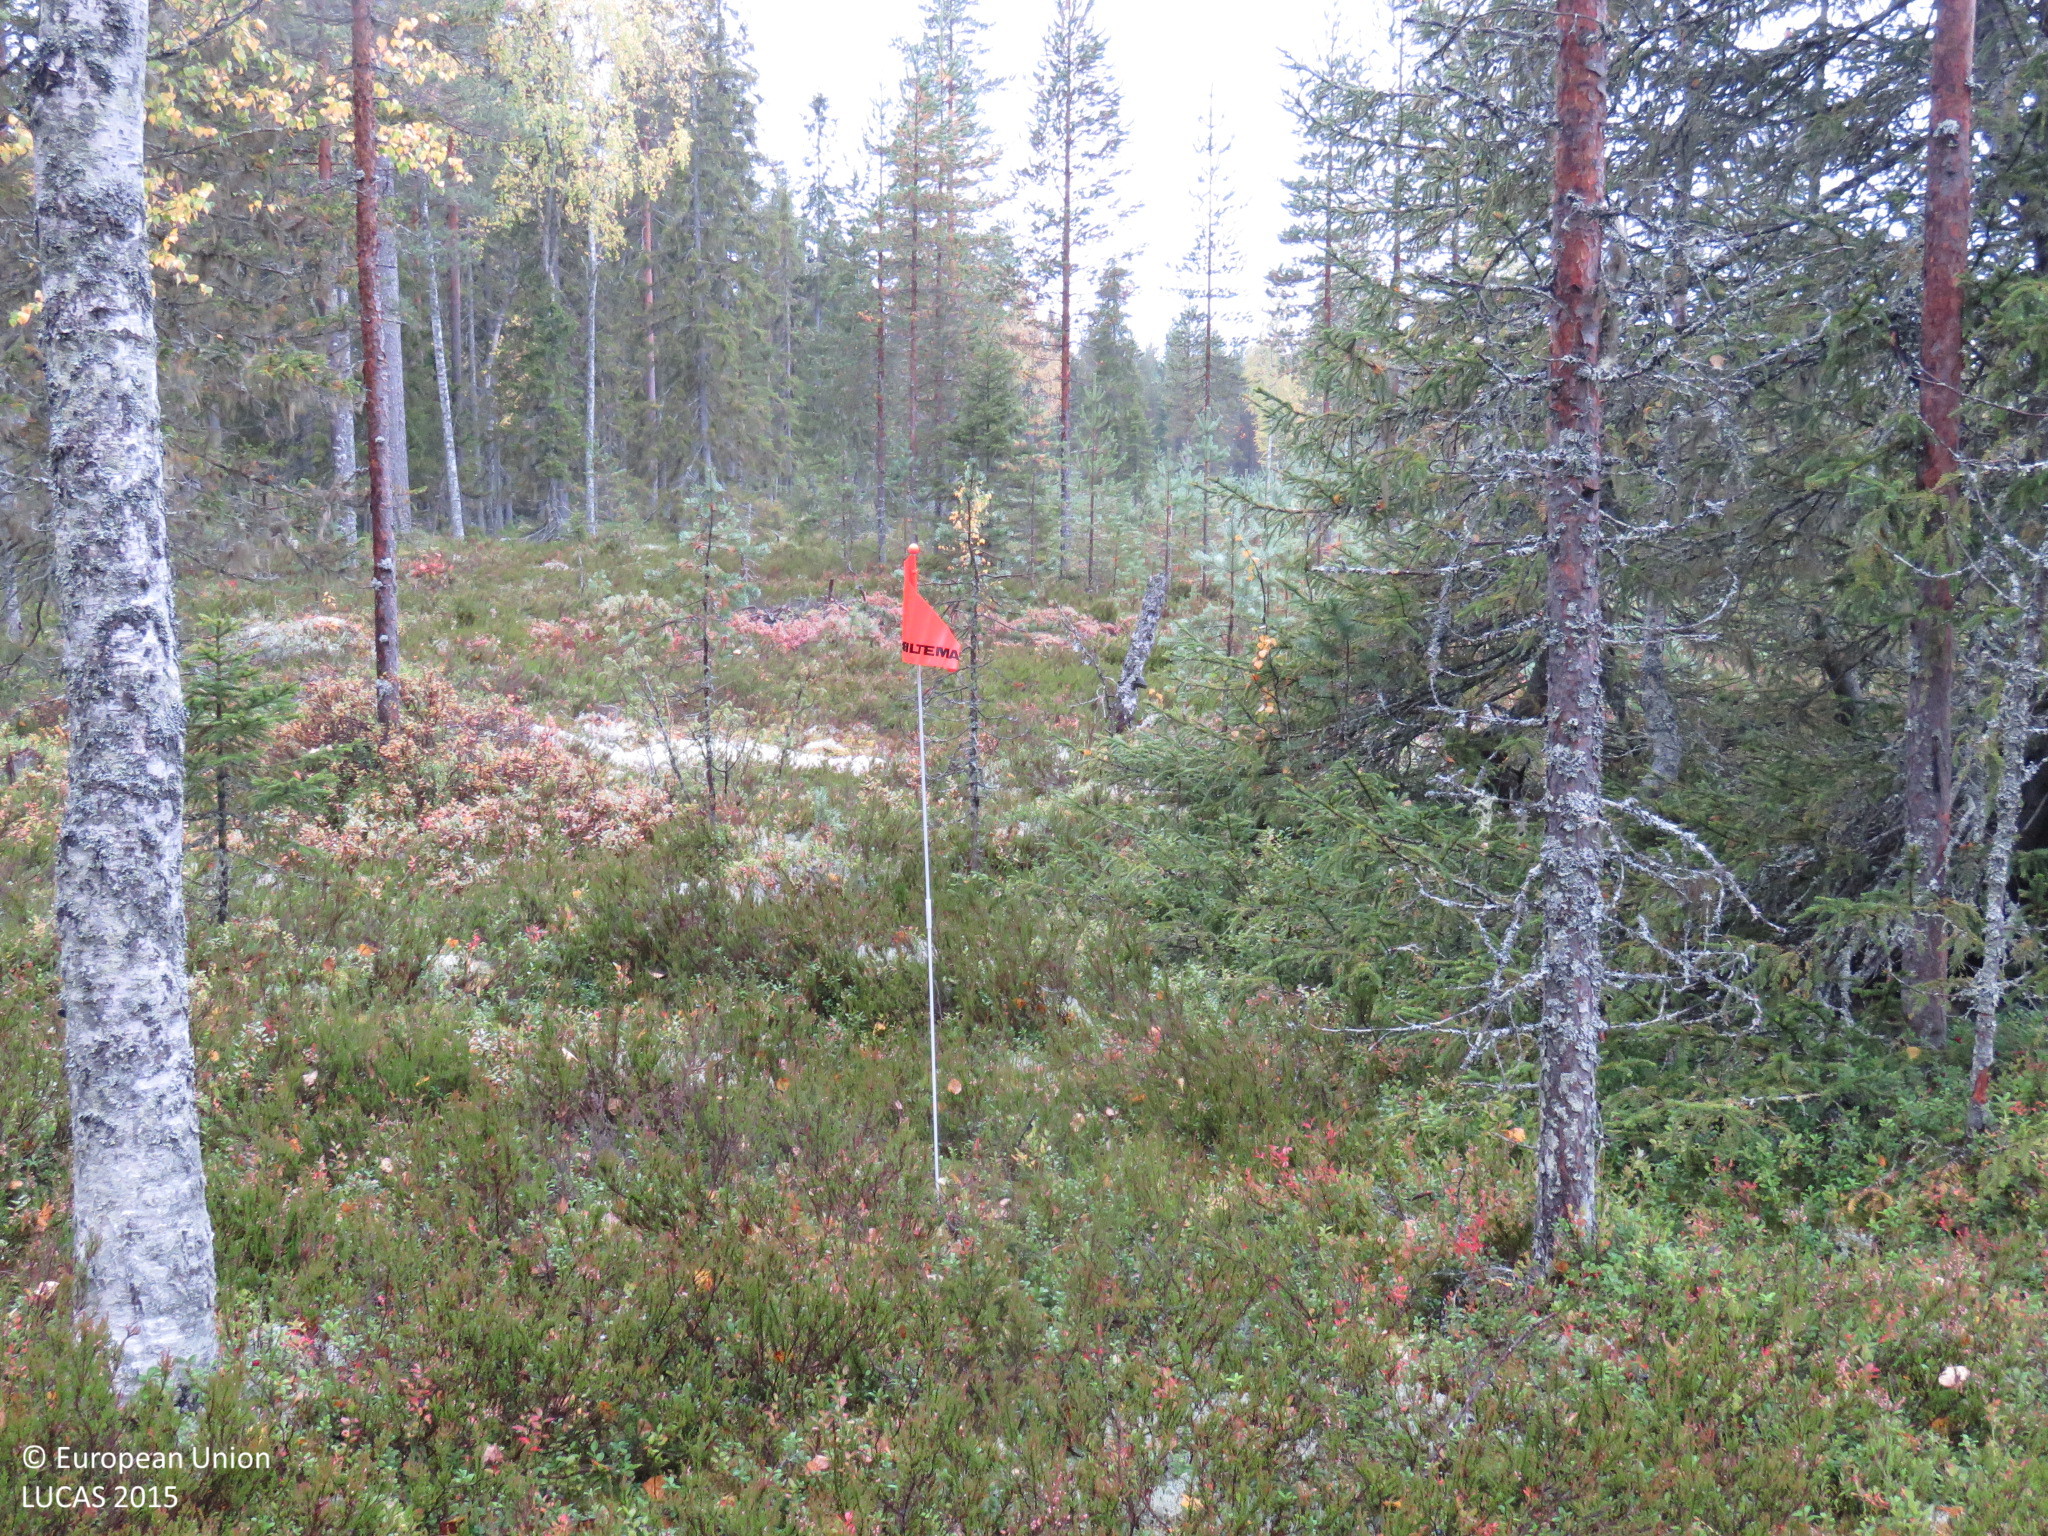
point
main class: Woodland
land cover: Other mixed woodland
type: boreal forest
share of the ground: 50 - 75 %
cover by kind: coniferous forest trees 45 %, broadleaved forest trees 25 %, shrubs 20 %, lichens and mosses 10 %
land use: Forestry
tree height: > 5 m
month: September
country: FI
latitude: 64.7960
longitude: 26.9387
